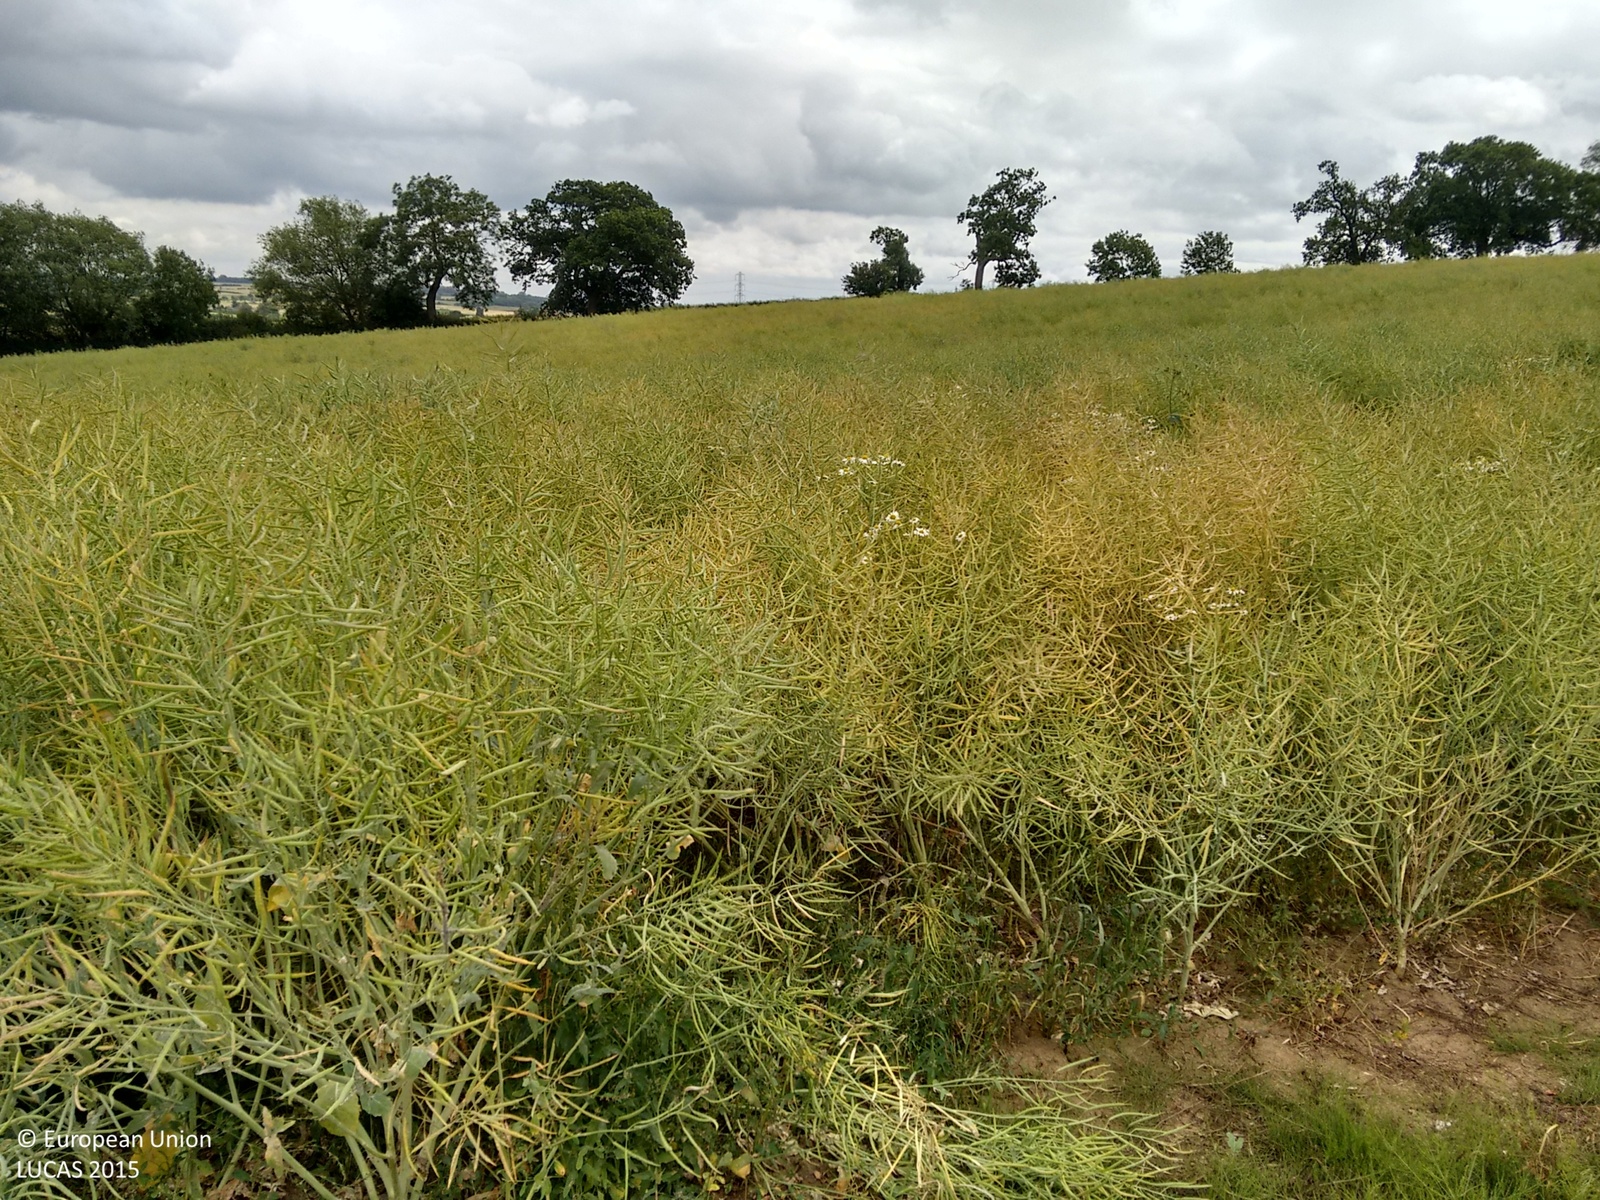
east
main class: Cropland
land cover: Rape and turnip rape
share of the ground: > 75 %
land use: Agriculture (excluding fallow land and kitchen gardens)
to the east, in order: Rape and turnip rape; Grass margins; Fences; Managed hedges; Single bushes/trees; Fences; Grassland without tree/shrub cover
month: July
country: GB
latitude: 52.6863
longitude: -0.9462
